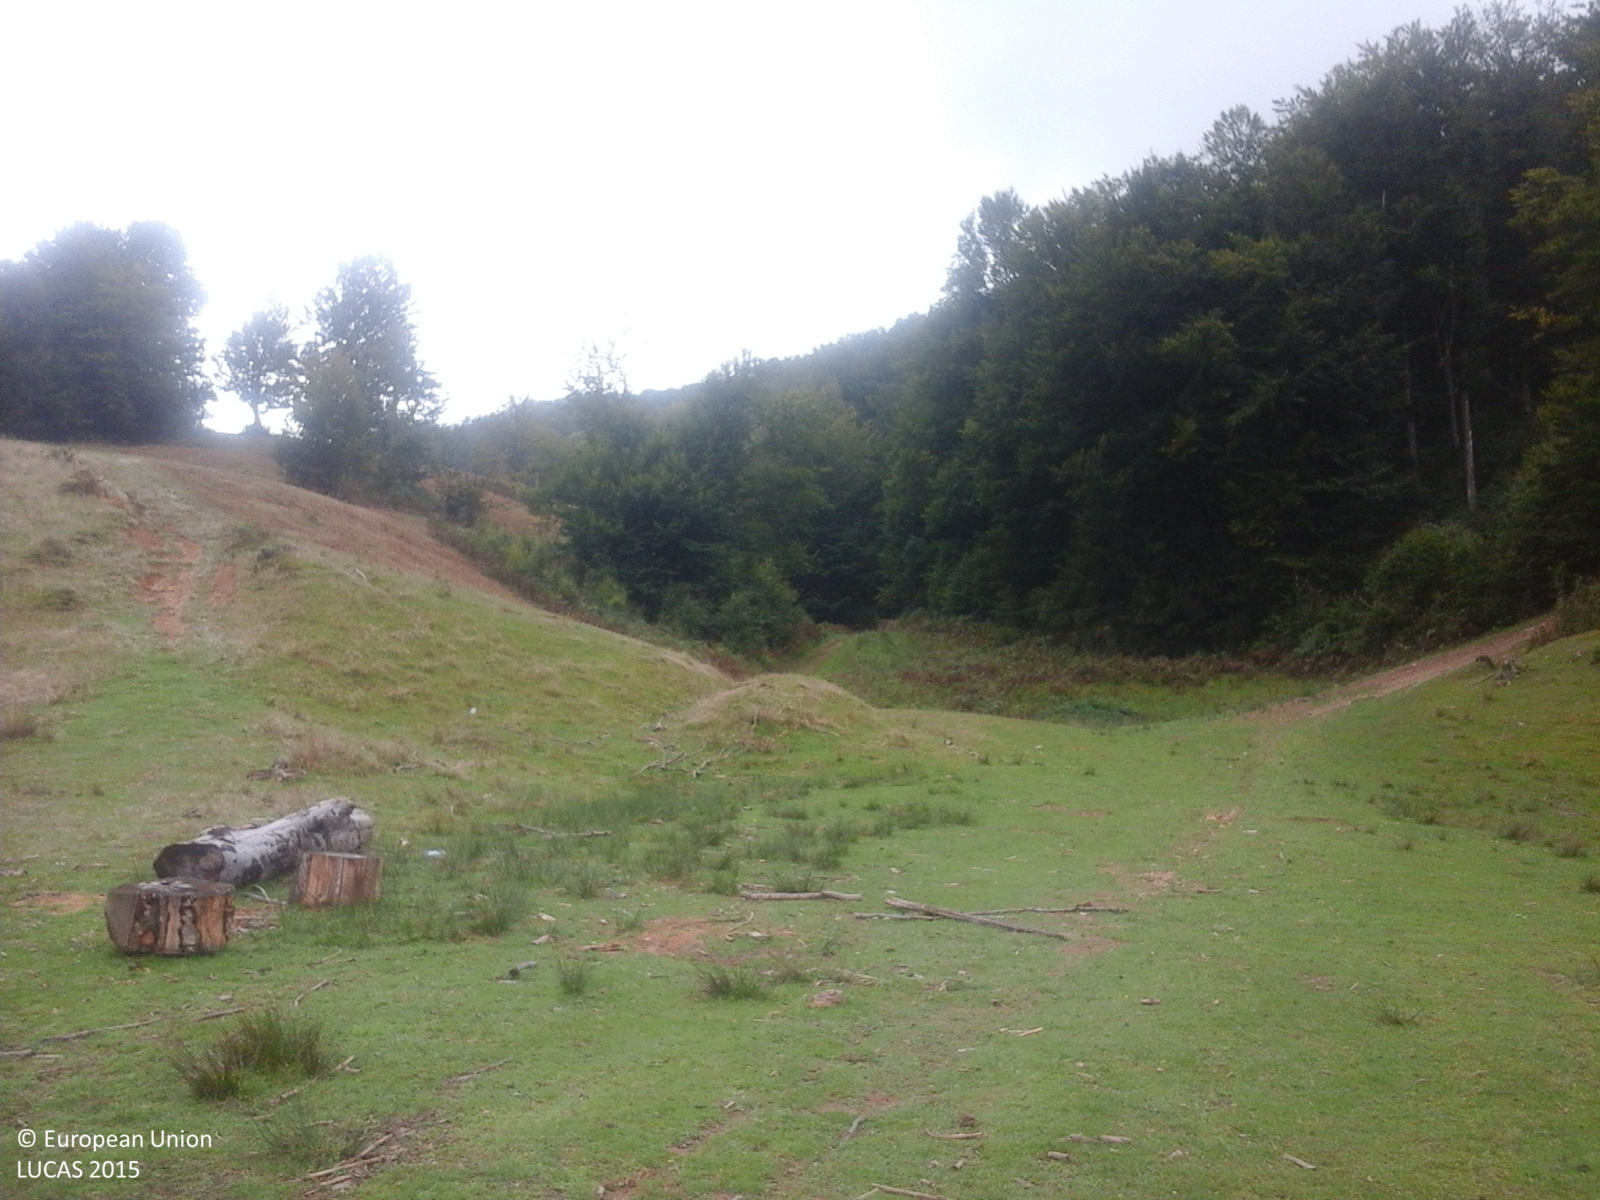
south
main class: Grassland
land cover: Grassland without tree/shrub cover
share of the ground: > 75 %
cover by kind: herbaceous plants 100 %
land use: Agriculture (excluding fallow land and kitchen gardens)
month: September
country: RO
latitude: 46.8563
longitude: 22.4740
